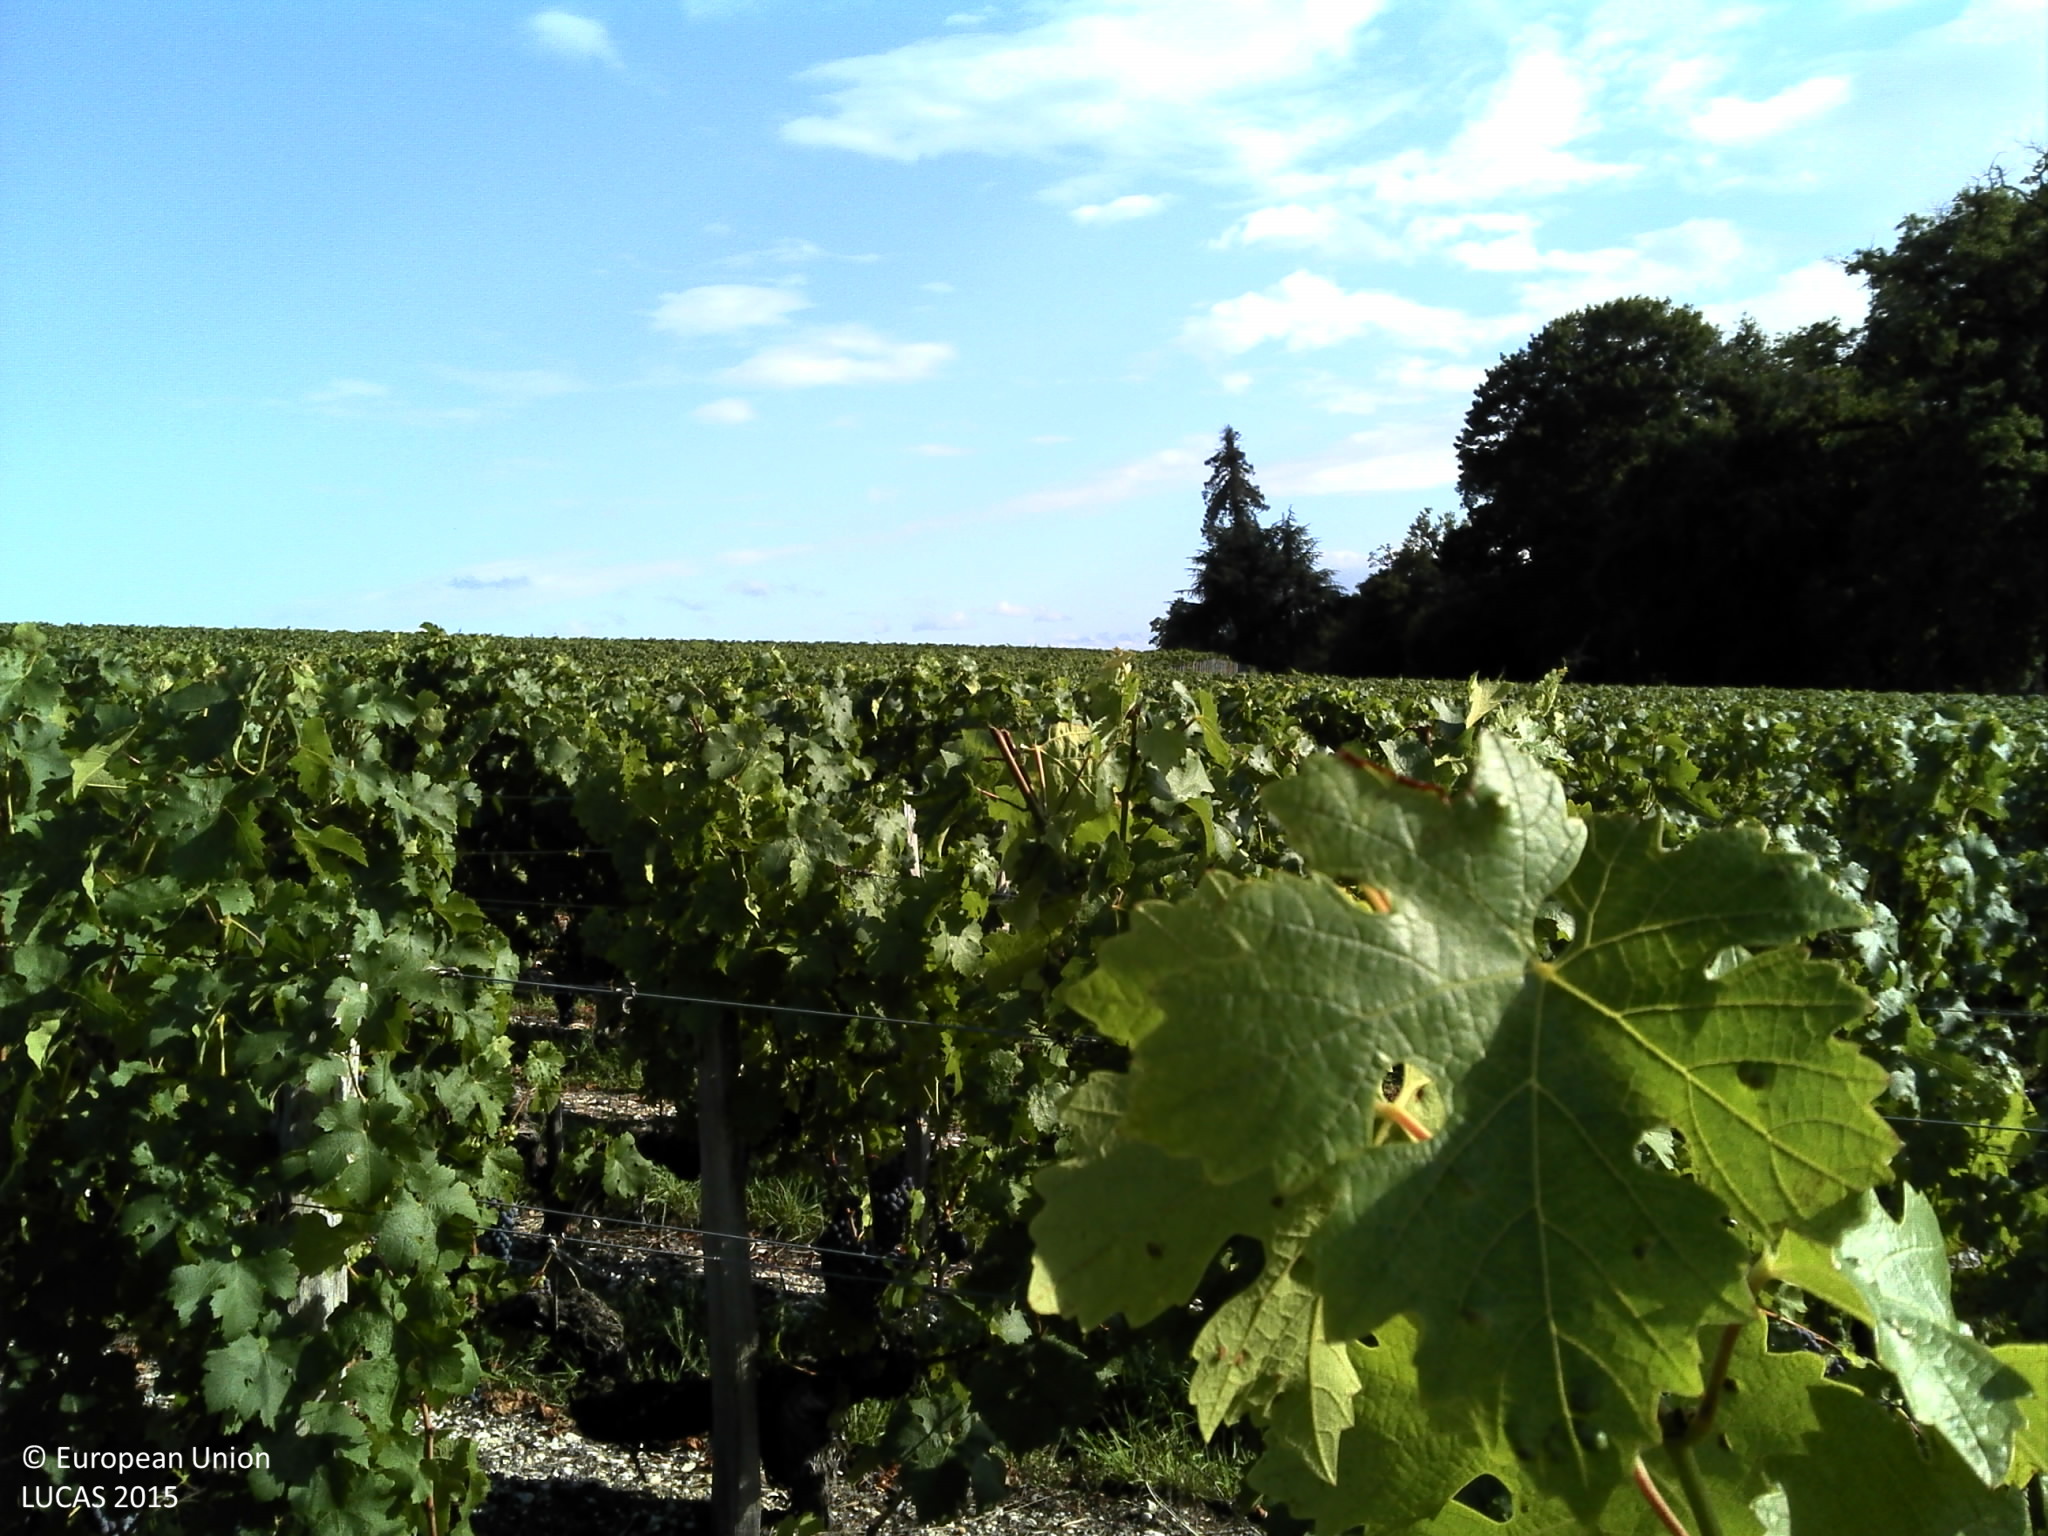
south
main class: Cropland
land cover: Vineyards
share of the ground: 25 - 50 %
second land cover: Grassland without tree/shrub cover
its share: > 75 %
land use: Agriculture (excluding fallow land and kitchen gardens)
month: August
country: FR
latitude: 45.1517
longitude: -0.7702
